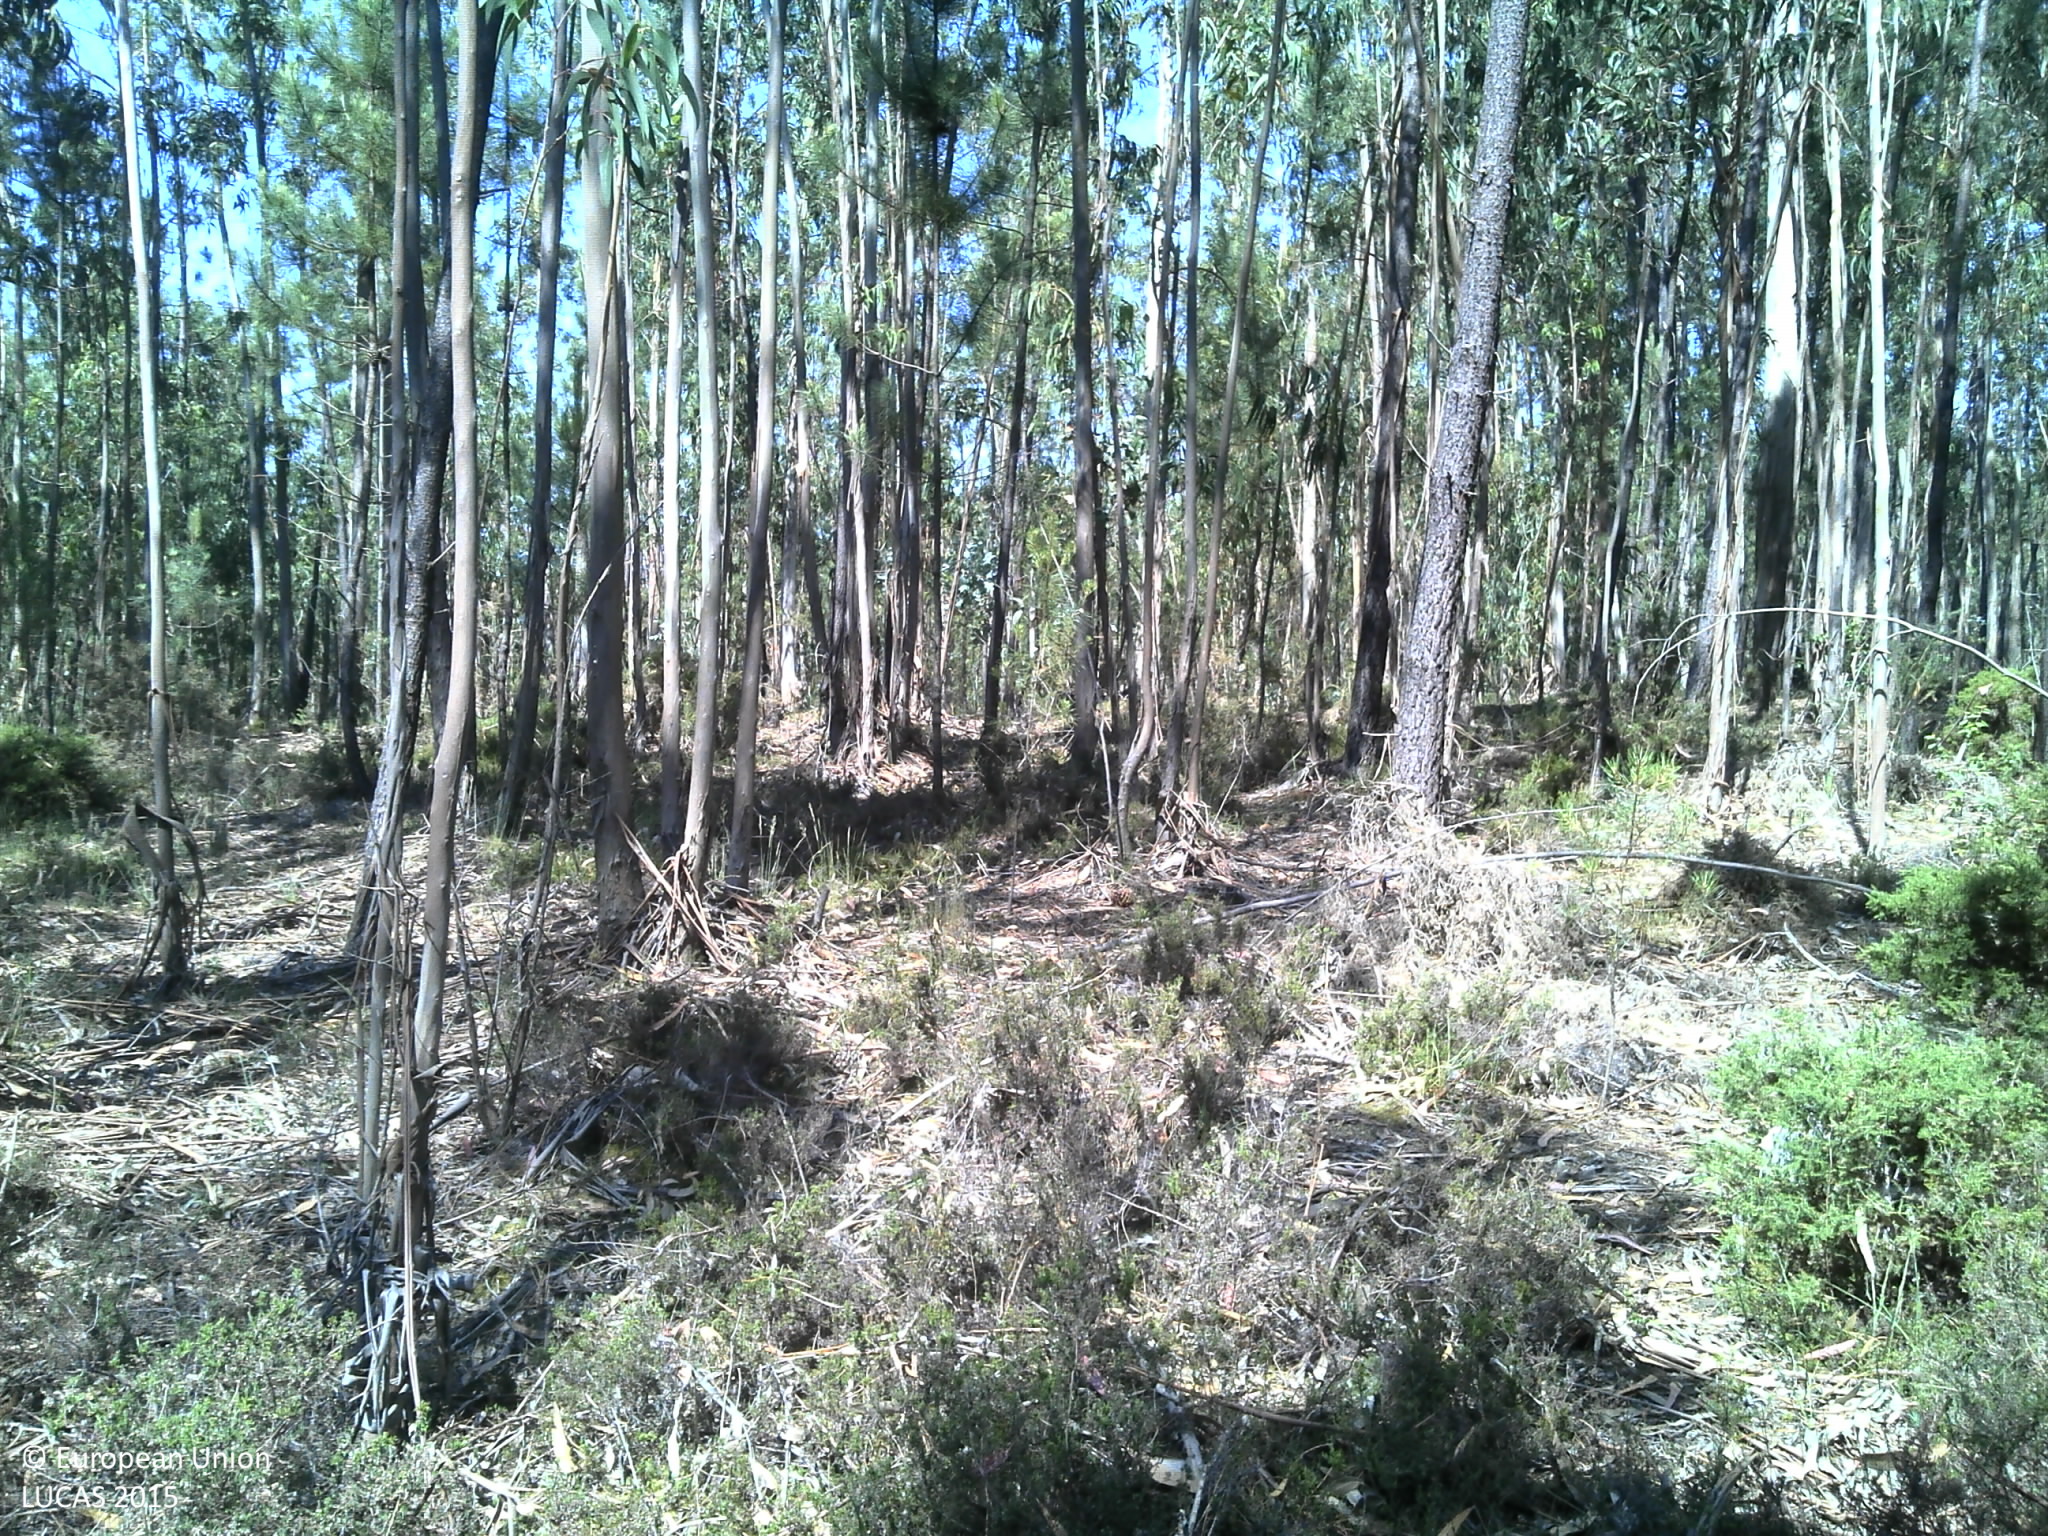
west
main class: Woodland
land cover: Broadleaved woodland
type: exotic forest
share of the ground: 50 - 75 %
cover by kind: broadleaved forest trees 70 %, shrubs 25 %, unconsolidated bare surface 5 %
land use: Forestry
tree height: > 5 m
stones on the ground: < 10 %
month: June
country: PT
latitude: 40.8195
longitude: -8.4114
